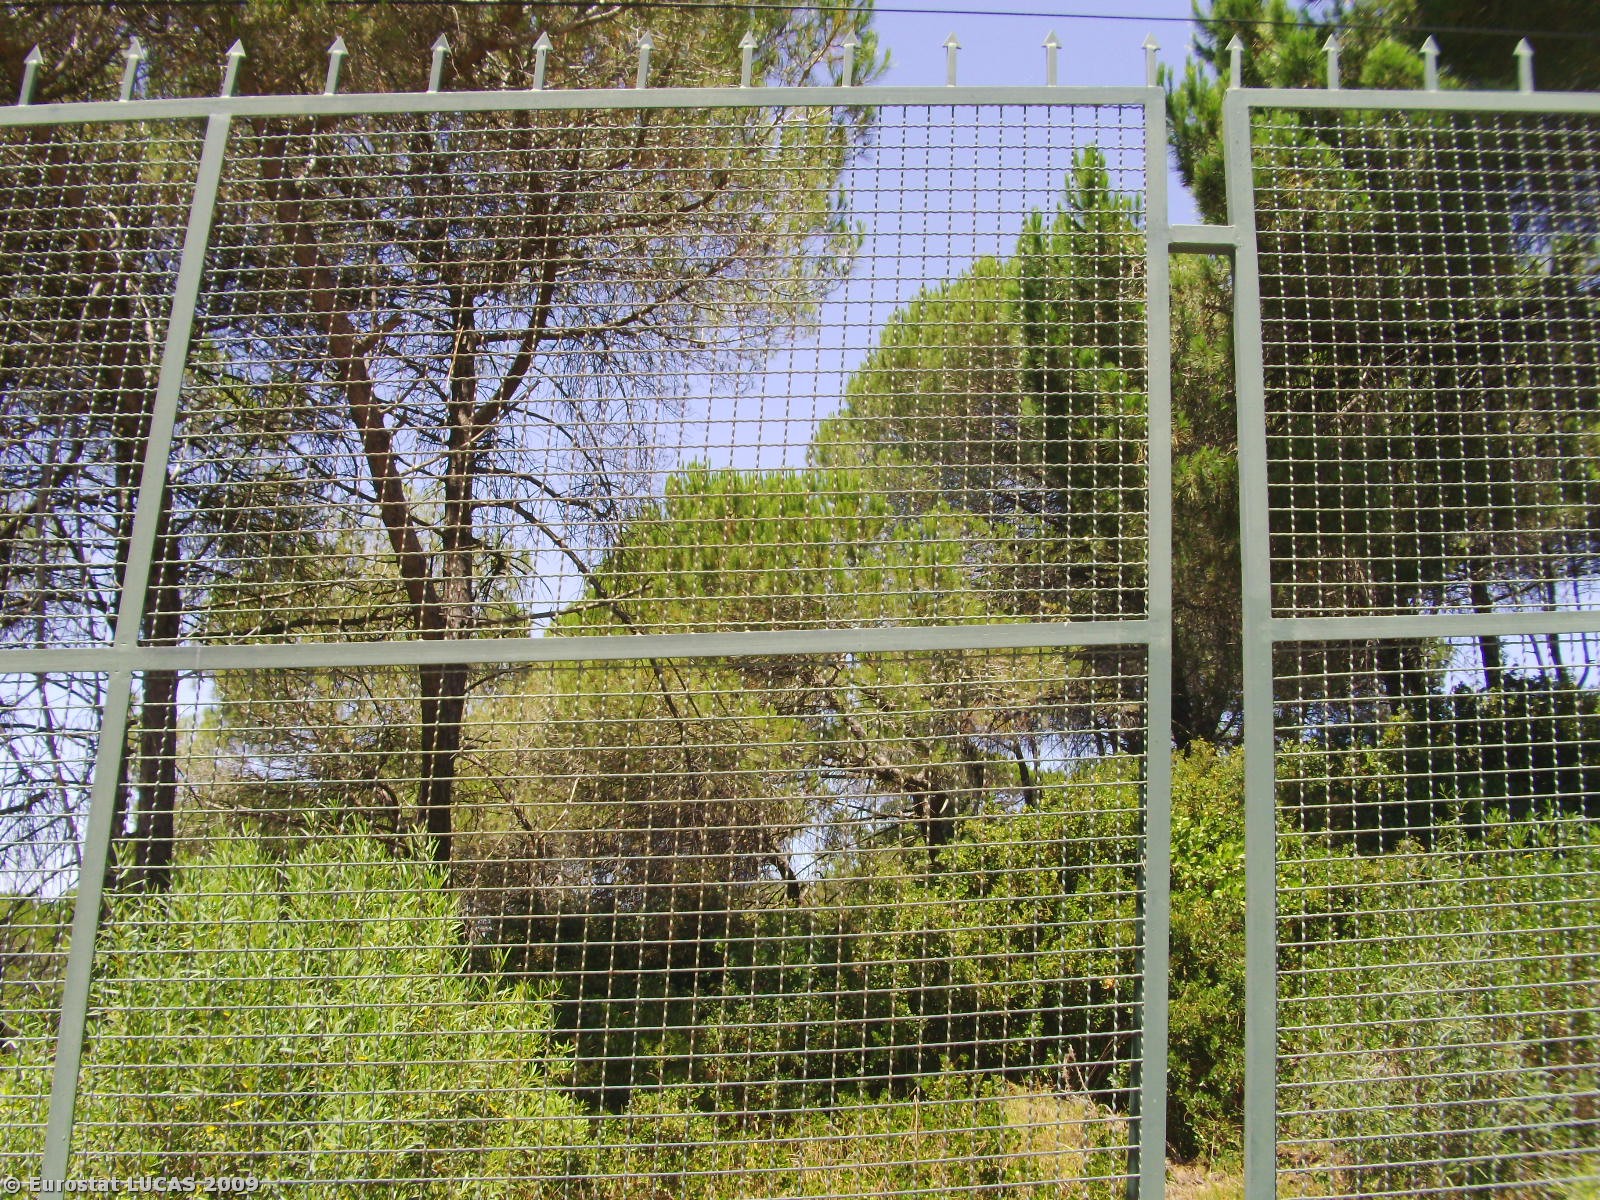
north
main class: Woodland
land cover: Coniferous woodland
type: coniferous forest of the mediterranean region
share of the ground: 25 - 50 %
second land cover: Shrubland with sparse tree cover
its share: 50 - 75 %
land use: Forestry
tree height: > 5 m
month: July
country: PT
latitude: 38.6247
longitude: -9.1285
